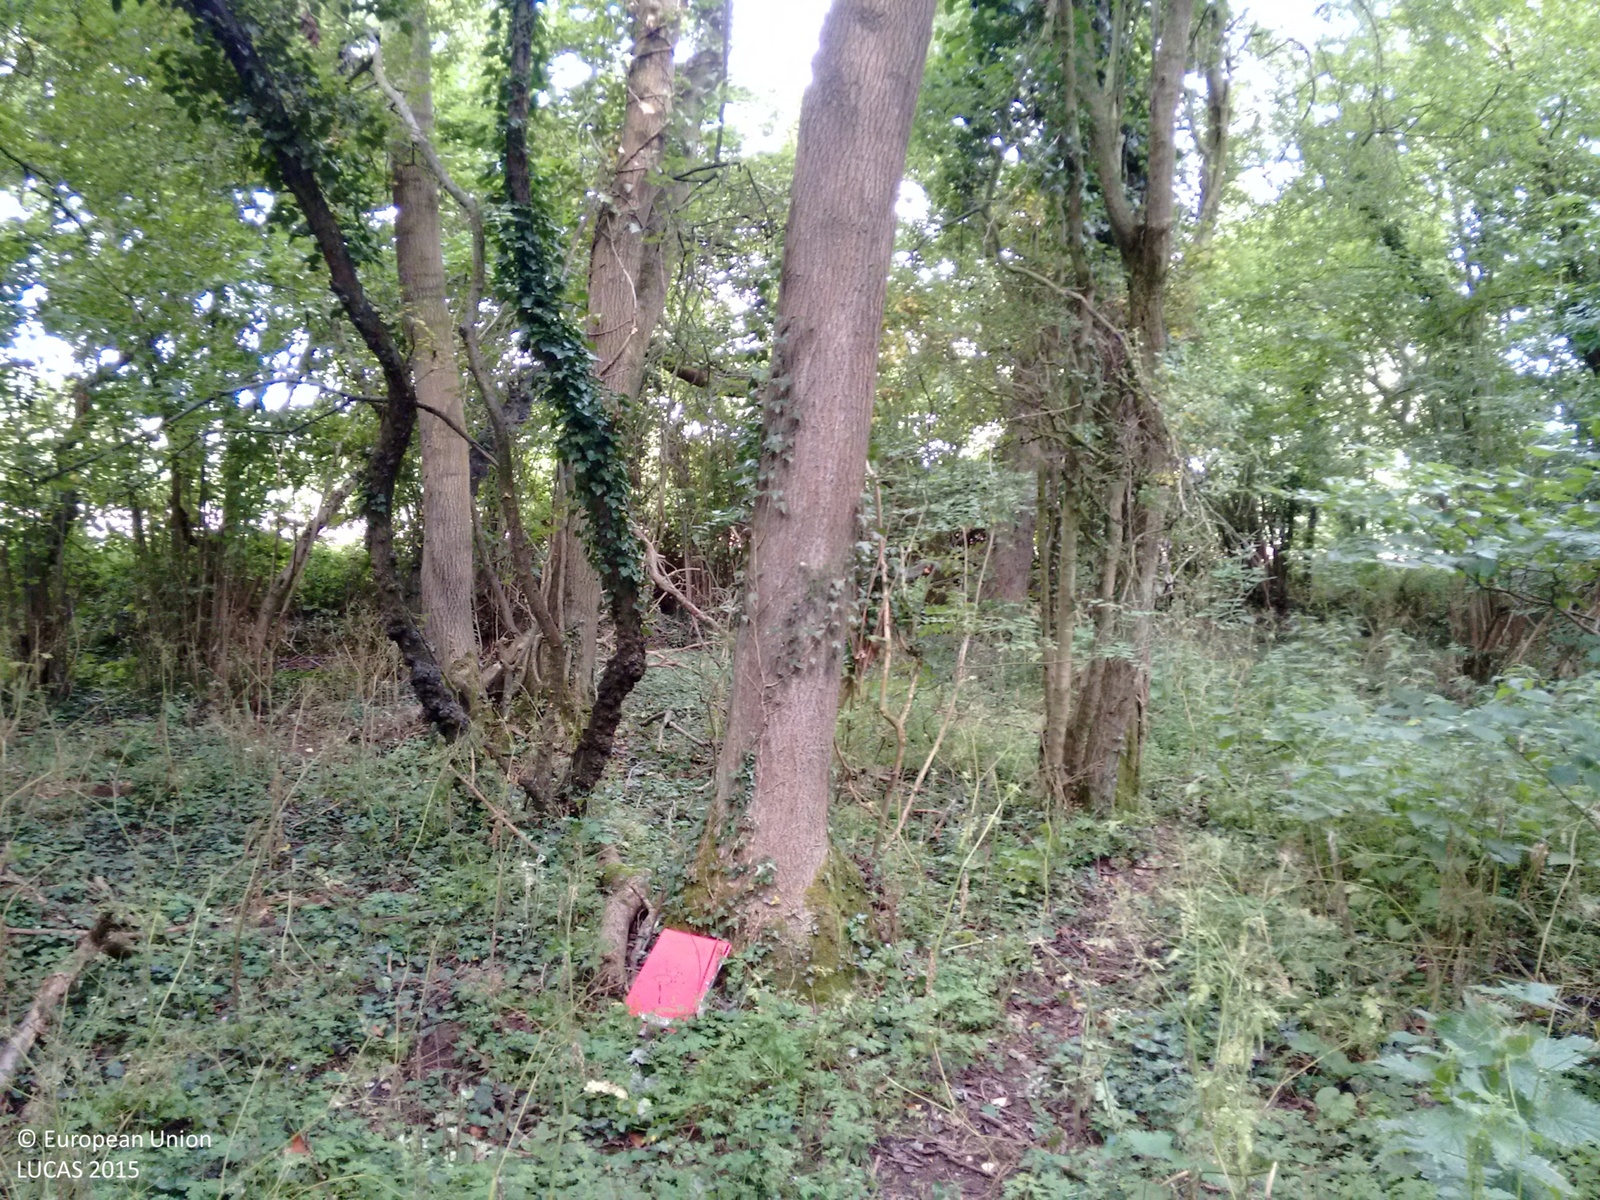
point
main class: Woodland
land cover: Broadleaved woodland
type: mesophytic deciduous forest
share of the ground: > 75 %
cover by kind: broadleaved forest trees 90 %, herbaceous plants 10 %
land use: Semi-natural and natural areas not in use
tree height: > 5 m
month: July
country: GB
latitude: 51.7317
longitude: -1.6218
